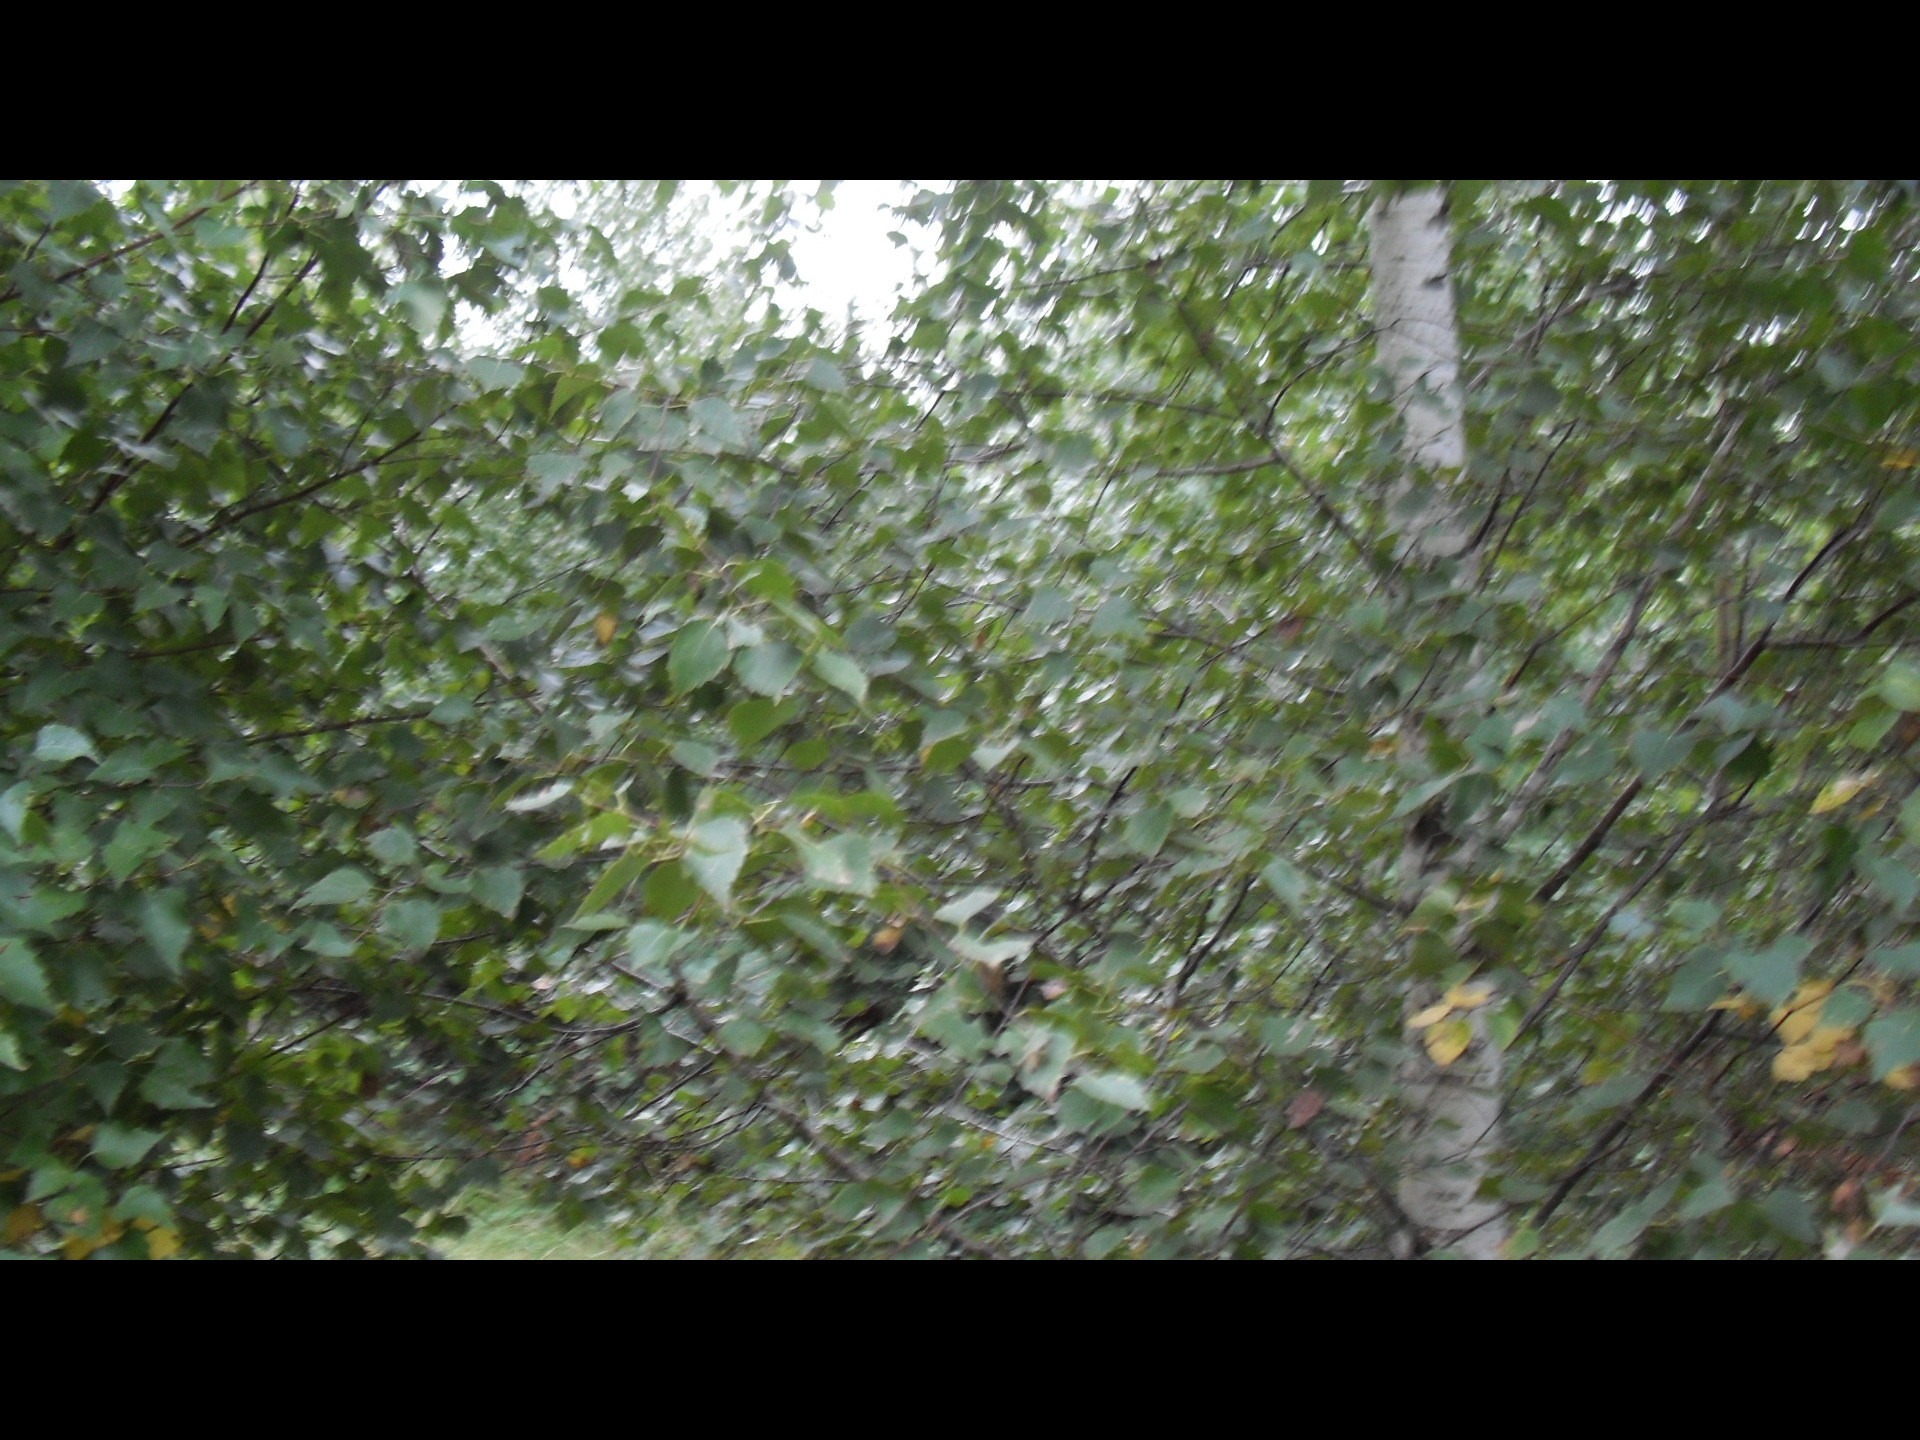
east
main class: Woodland
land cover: Broadleaved woodland
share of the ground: > 75 %
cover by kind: broadleaved forest trees 85 %, coniferous forest trees 10 %, shrubs 5 %
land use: Semi-natural and natural areas not in use
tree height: < 5 m
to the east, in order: Broadleaved woodland; Grassland with sparse tree/shrub cover; Tracks; Grassland with sparse tree/shrub cover; Tracks; Pine dominated mixed woodland
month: October
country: BG
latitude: 43.3887
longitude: 22.8104
